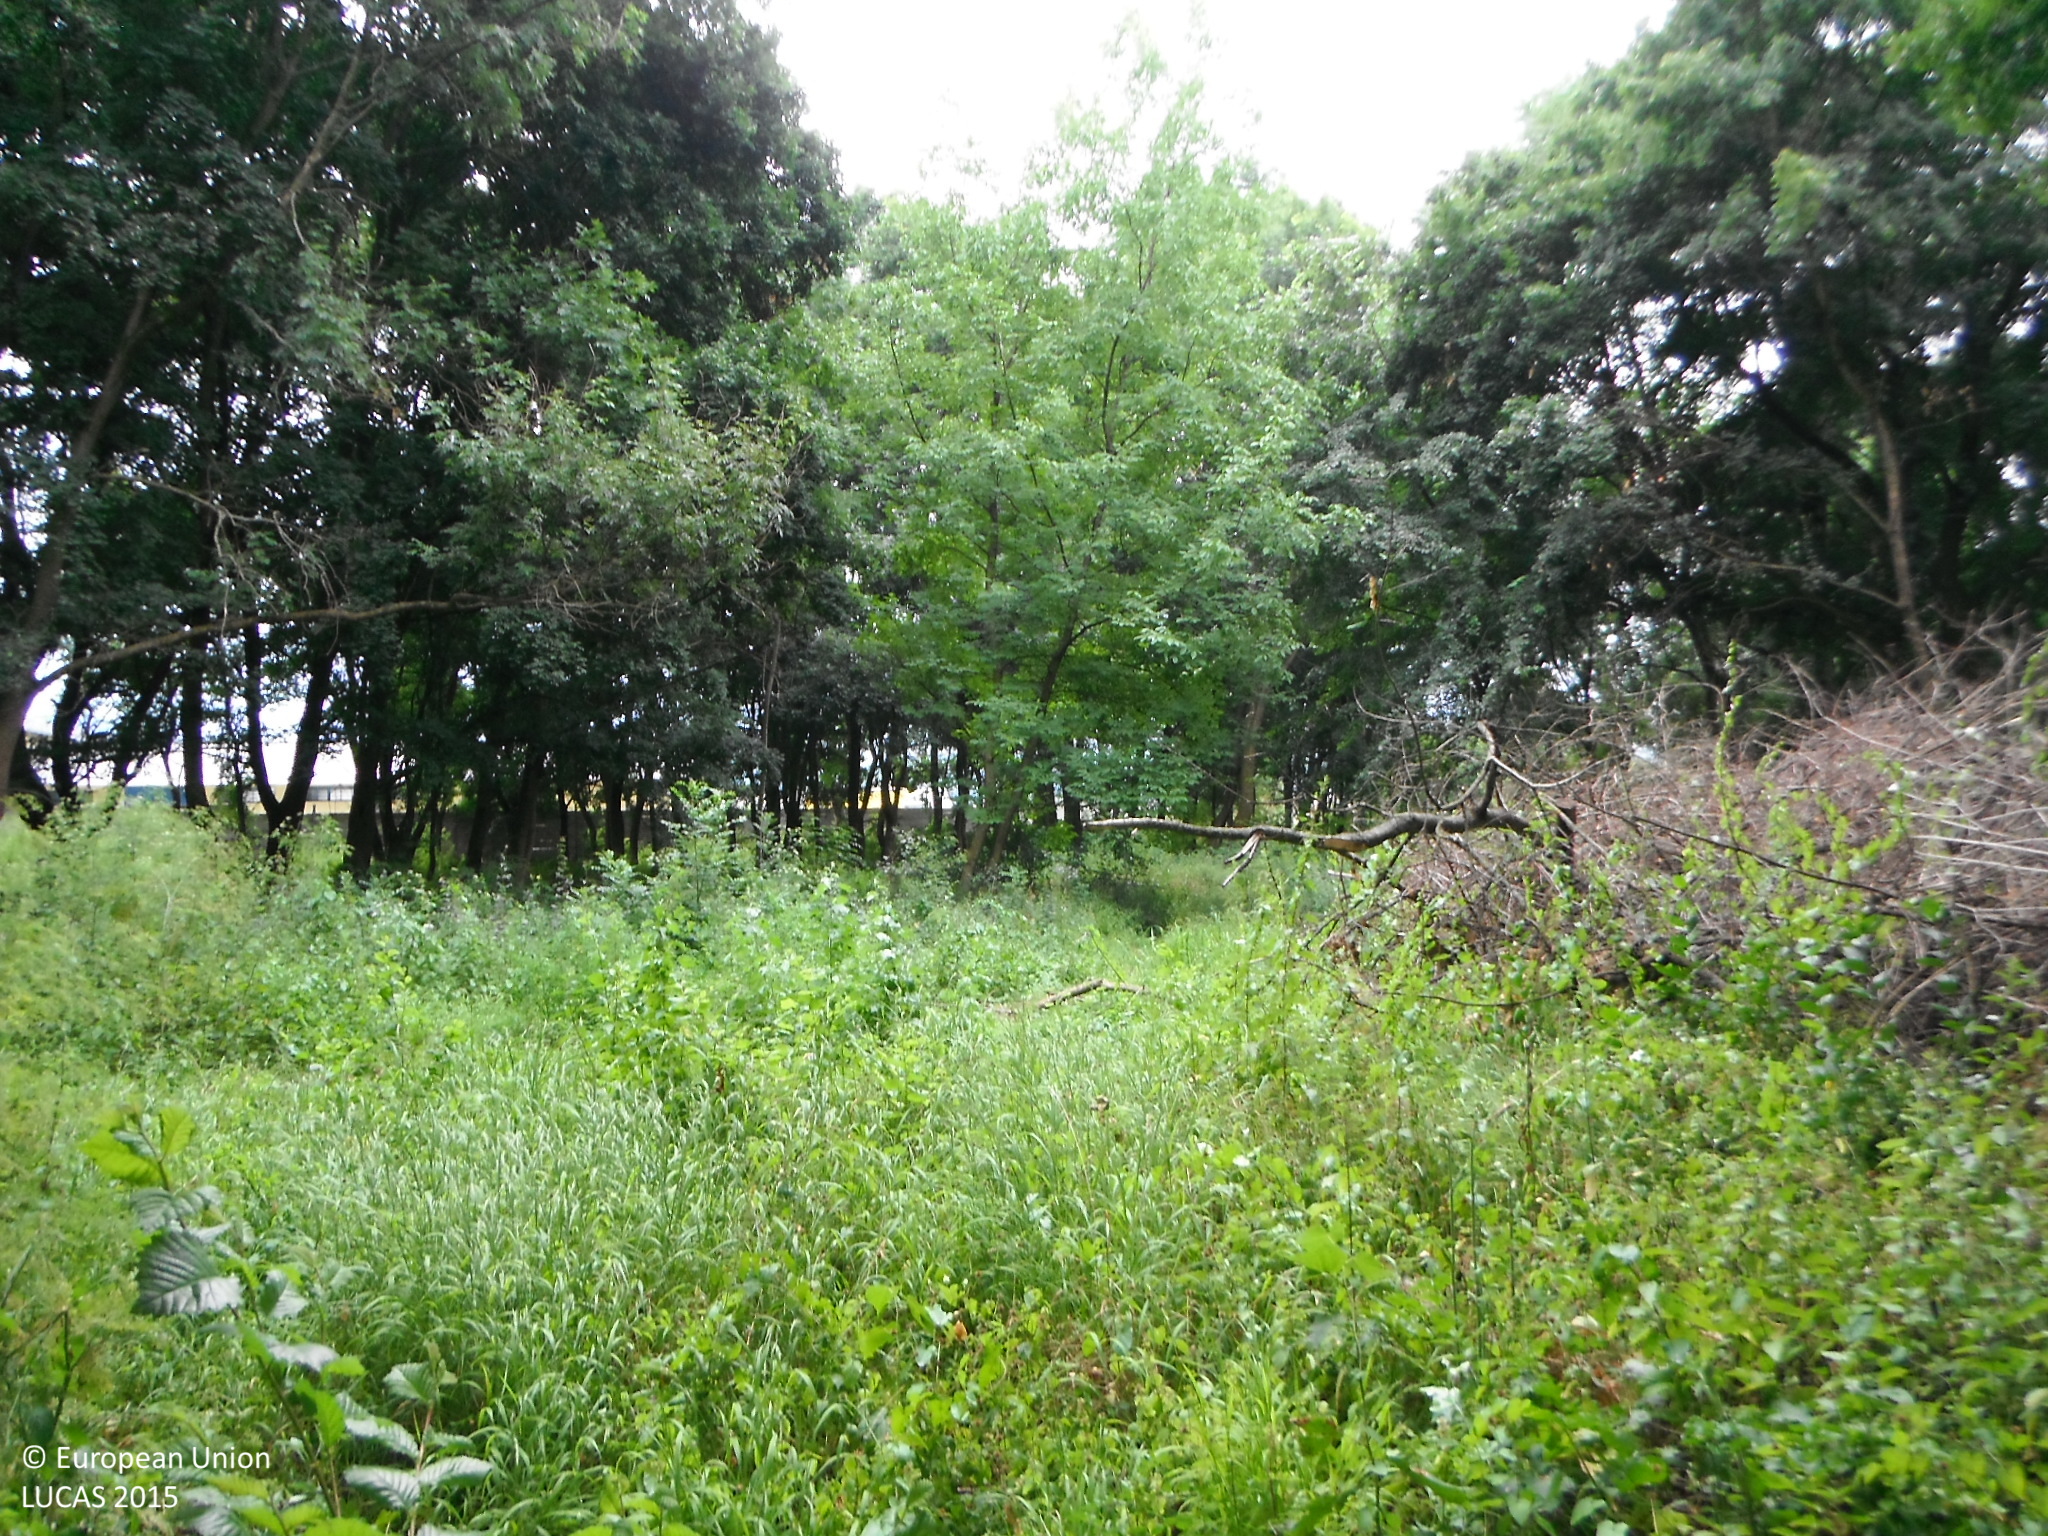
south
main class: Woodland
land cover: Broadleaved woodland
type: mesophytic deciduous forest
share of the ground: 50 - 75 %
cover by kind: broadleaved forest trees 50 %, herbaceous plants 40 %, shrubs 10 %
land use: Amenities, museums, leisure
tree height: > 5 m
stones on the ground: < 10 %
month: July
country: SK
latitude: 48.6311
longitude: 18.3336
